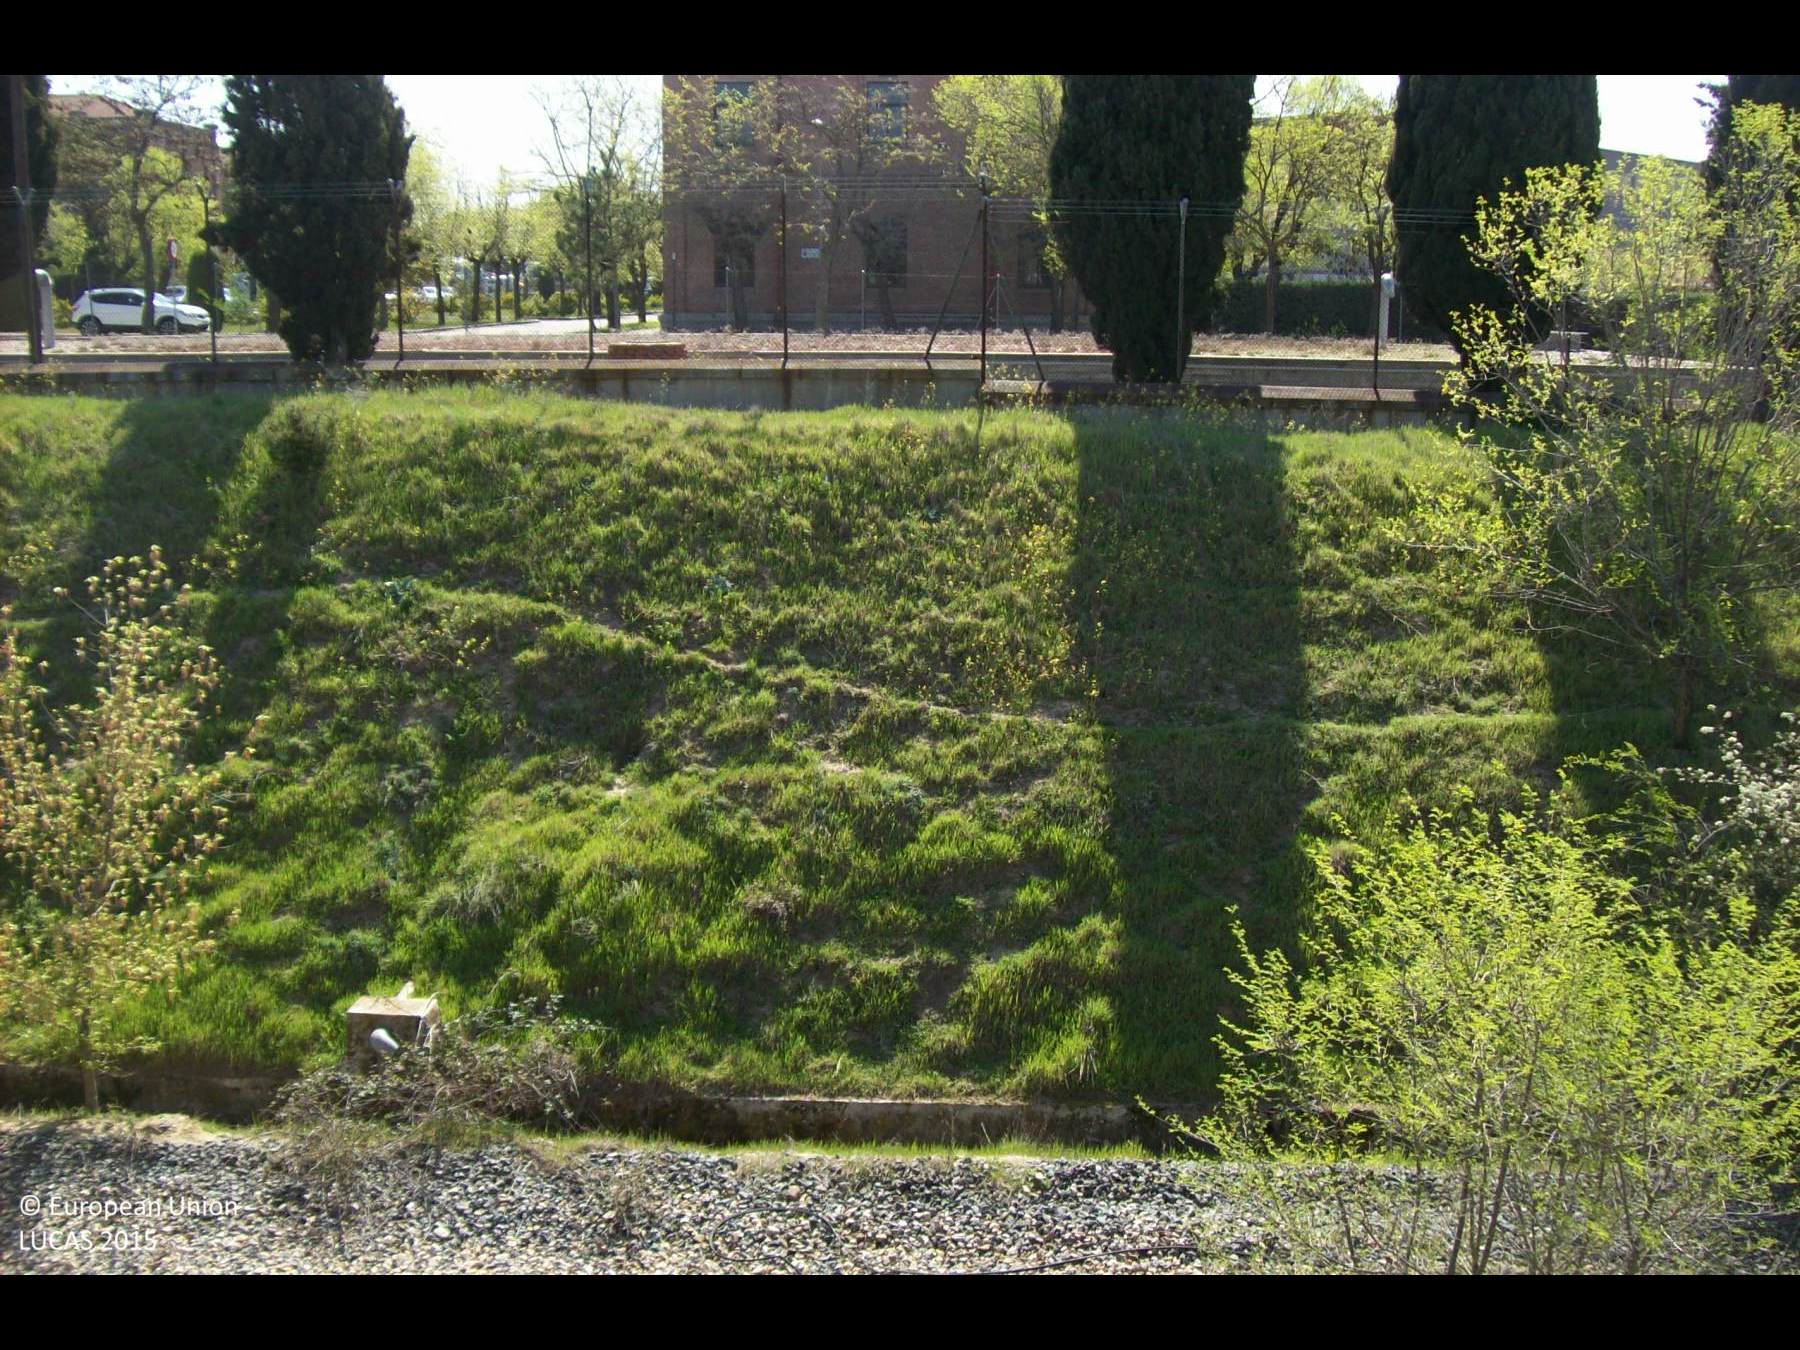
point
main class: Grassland
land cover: Grassland without tree/shrub cover
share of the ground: 50 - 75 %
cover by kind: herbaceous plants 70 %
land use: Community services
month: April
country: ES
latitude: 40.3672
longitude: -3.8051
